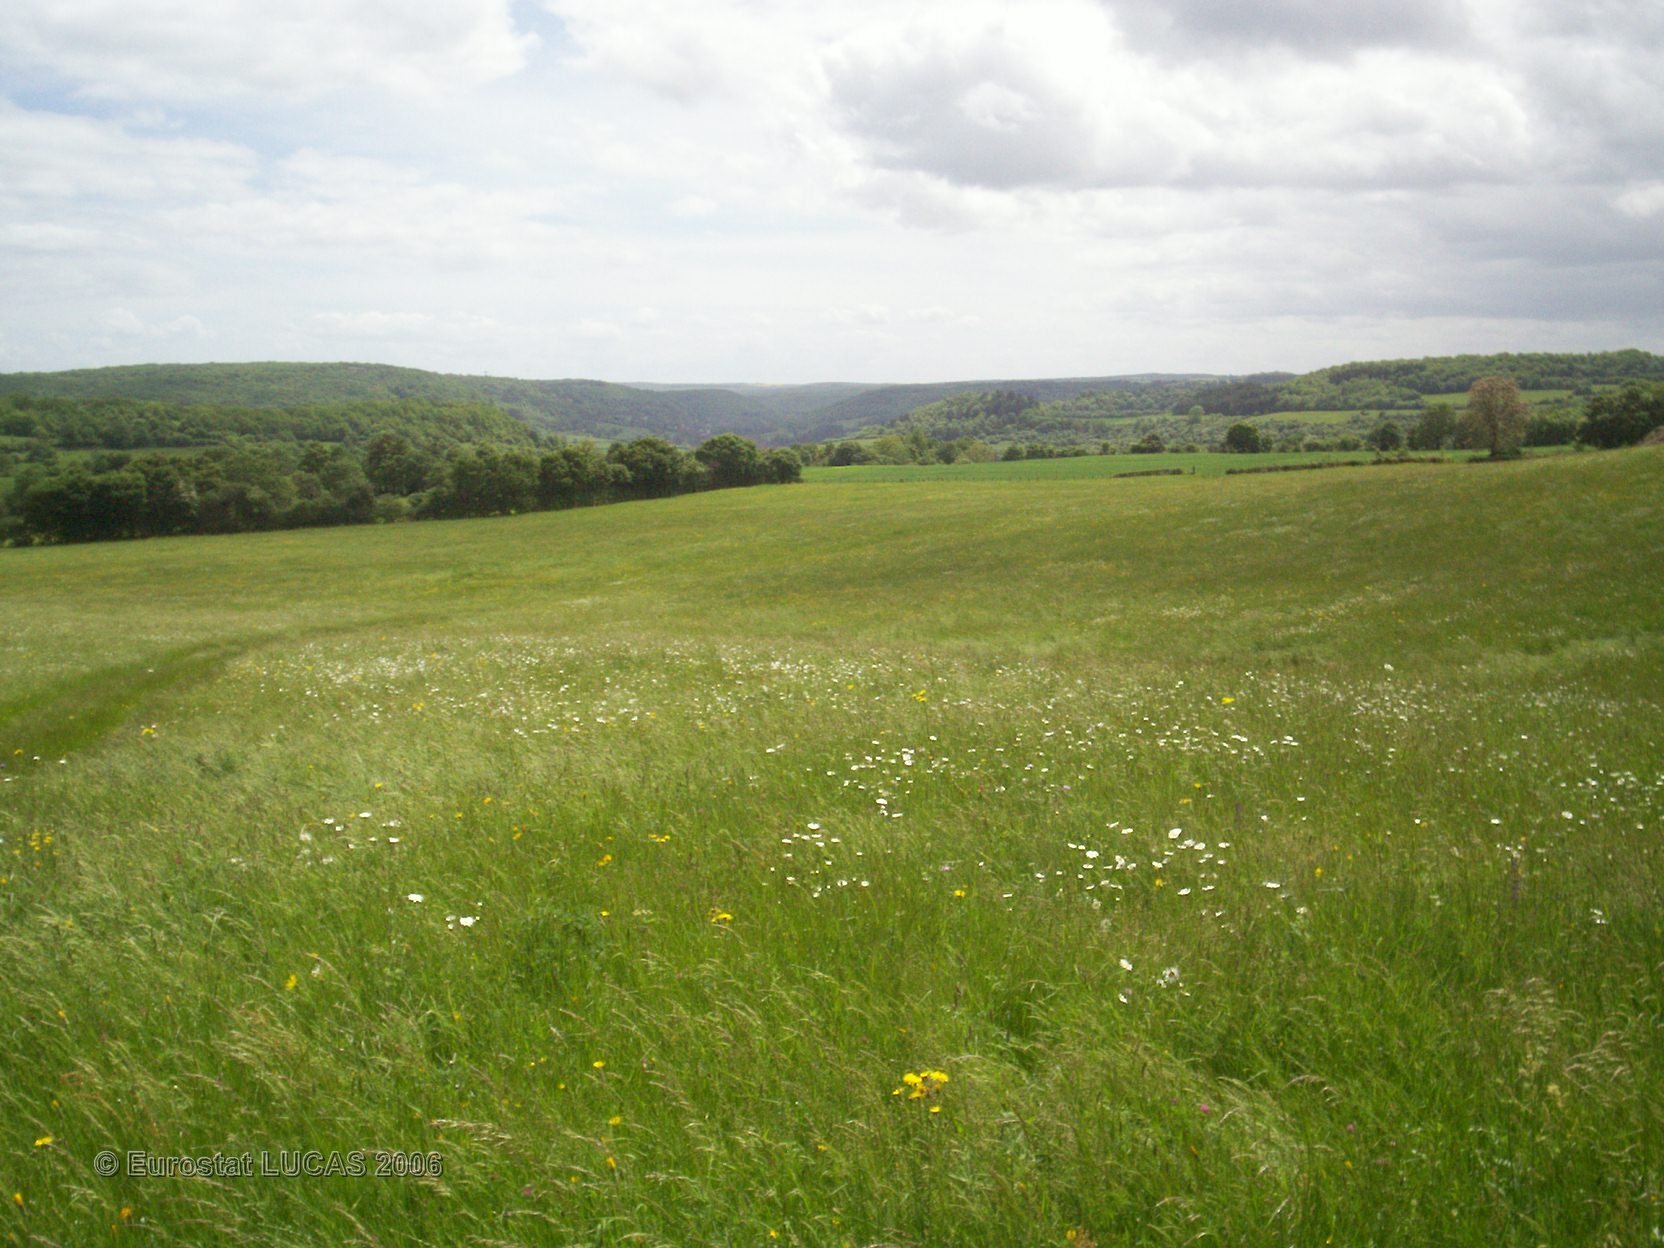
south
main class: Grassland
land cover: Grassland without tree/shrub cover
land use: Agriculture (excluding fallow land and kitchen gardens)
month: May
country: FR
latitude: 47.1382
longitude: 4.6602
